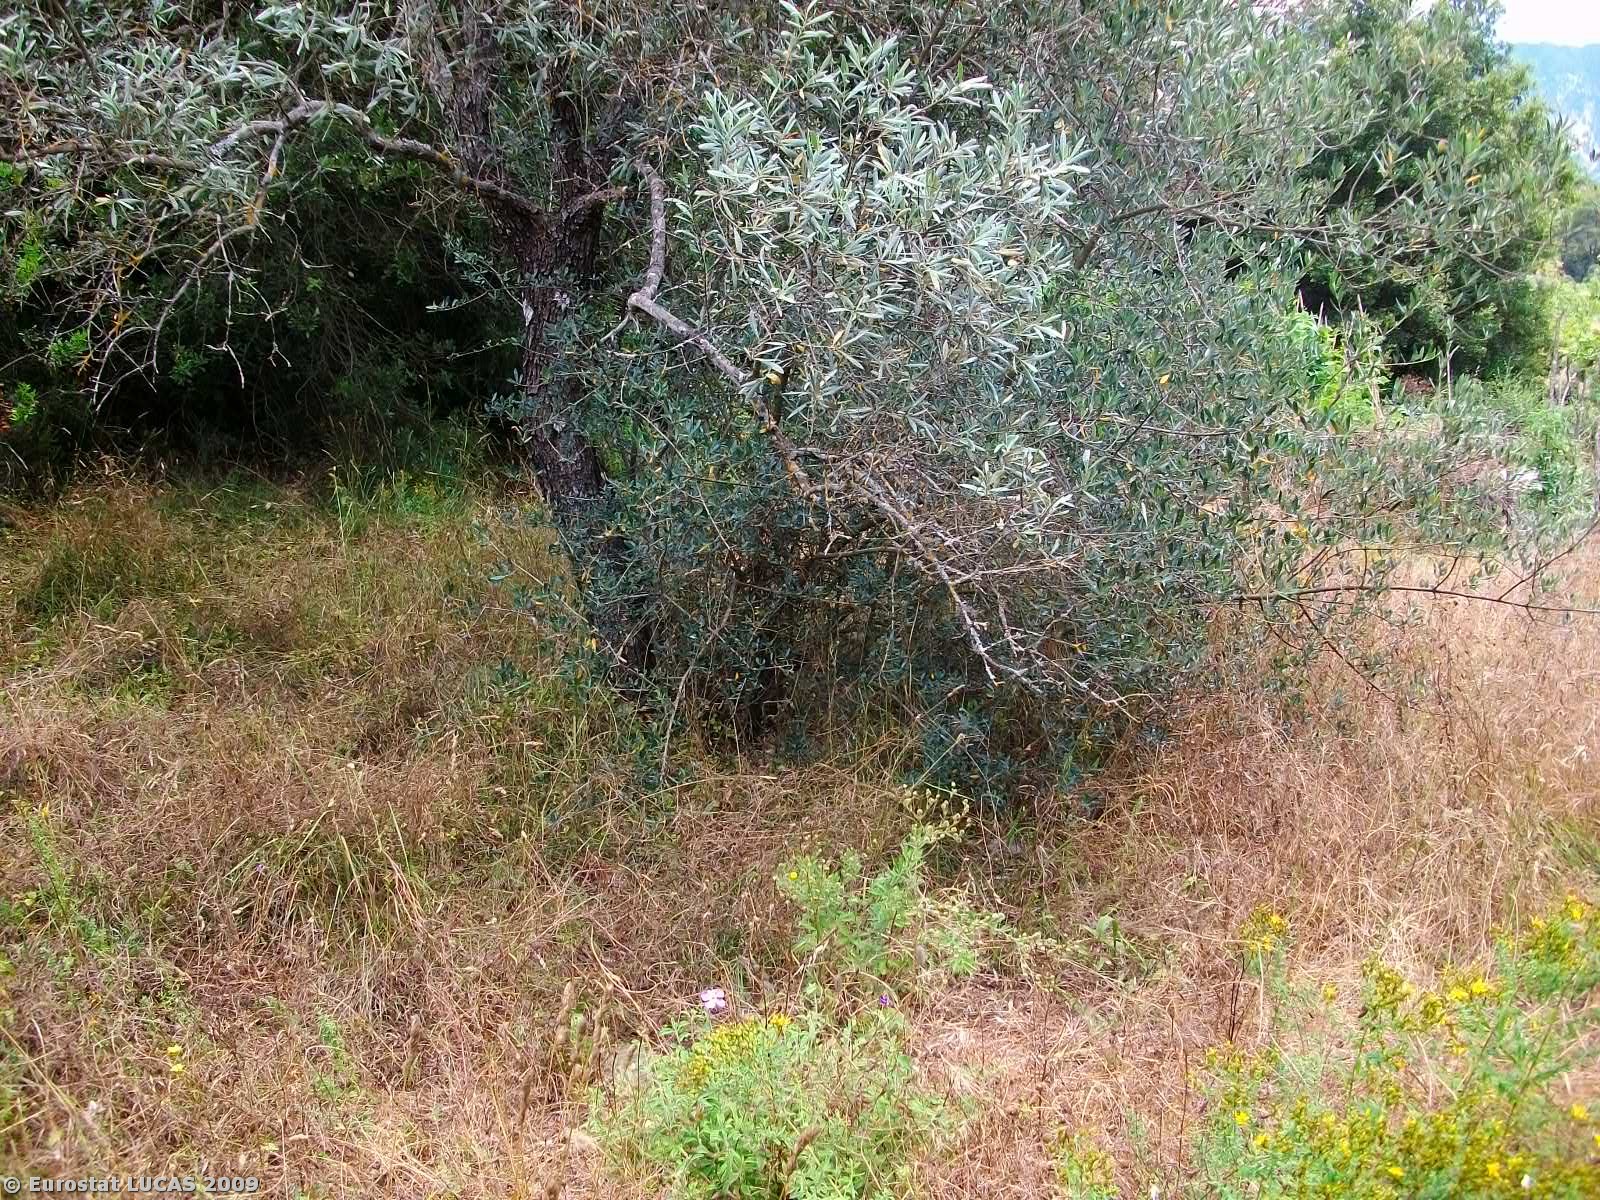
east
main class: Woodland
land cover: Broadleaved woodland
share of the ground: > 75 %
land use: Forestry
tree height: < 5 m
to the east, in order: Broadleaved woodland; Spontaneously vegetated surfaces; Fences; Abandoned hedges; Artificial constructions in urban areas; Broadleaved woodland; Paved roads, cycling and walking lanes; Broadleaved woodland
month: June
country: GR
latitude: 38.8570
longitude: 21.5084
